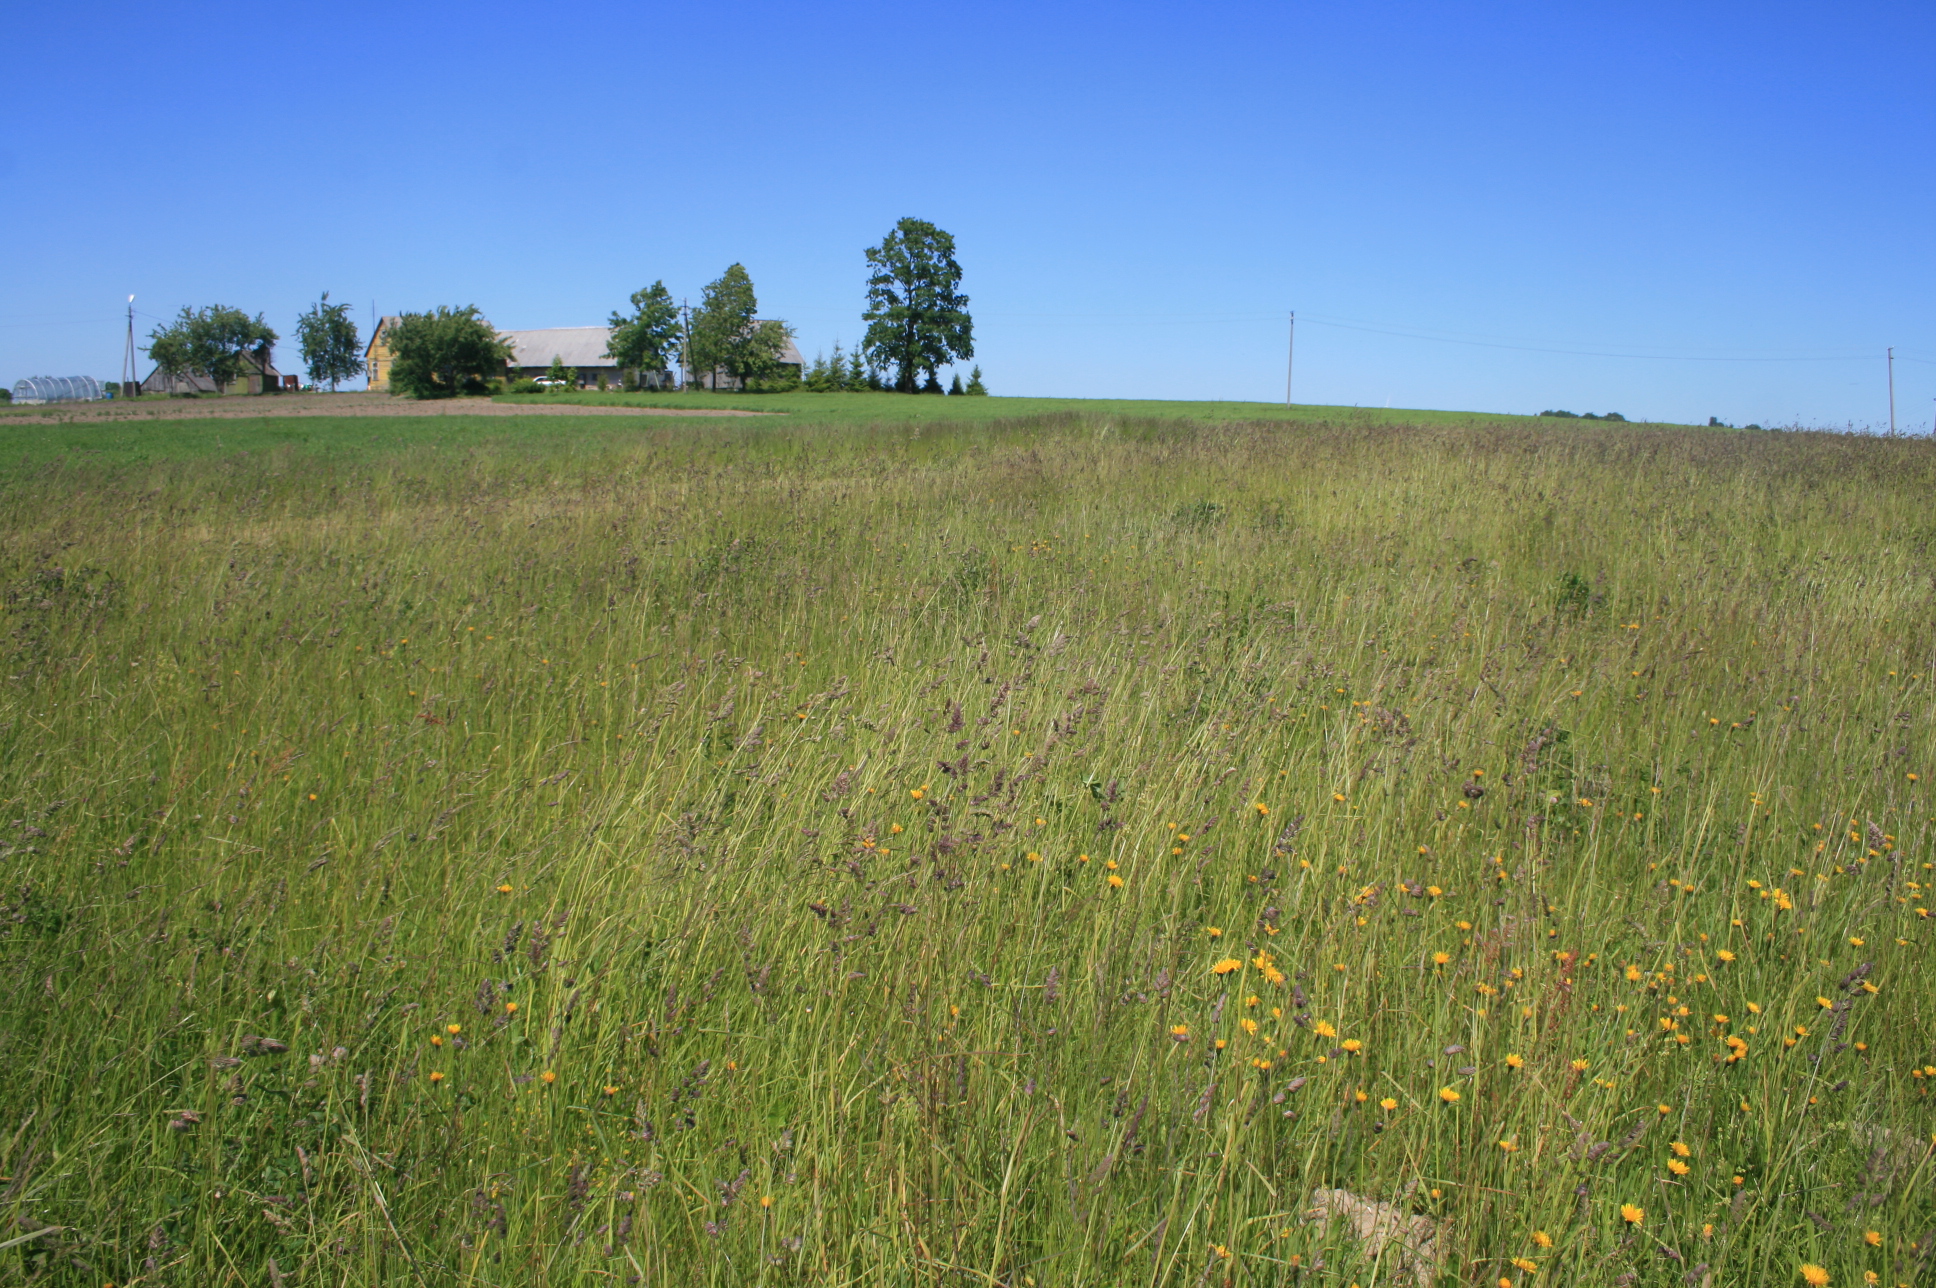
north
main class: Grassland
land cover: Grassland without tree/shrub cover
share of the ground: > 75 %
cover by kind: herbaceous plants 100 %
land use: Agriculture (excluding fallow land and kitchen gardens)
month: June
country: LT
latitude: 55.5148
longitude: 22.1707
